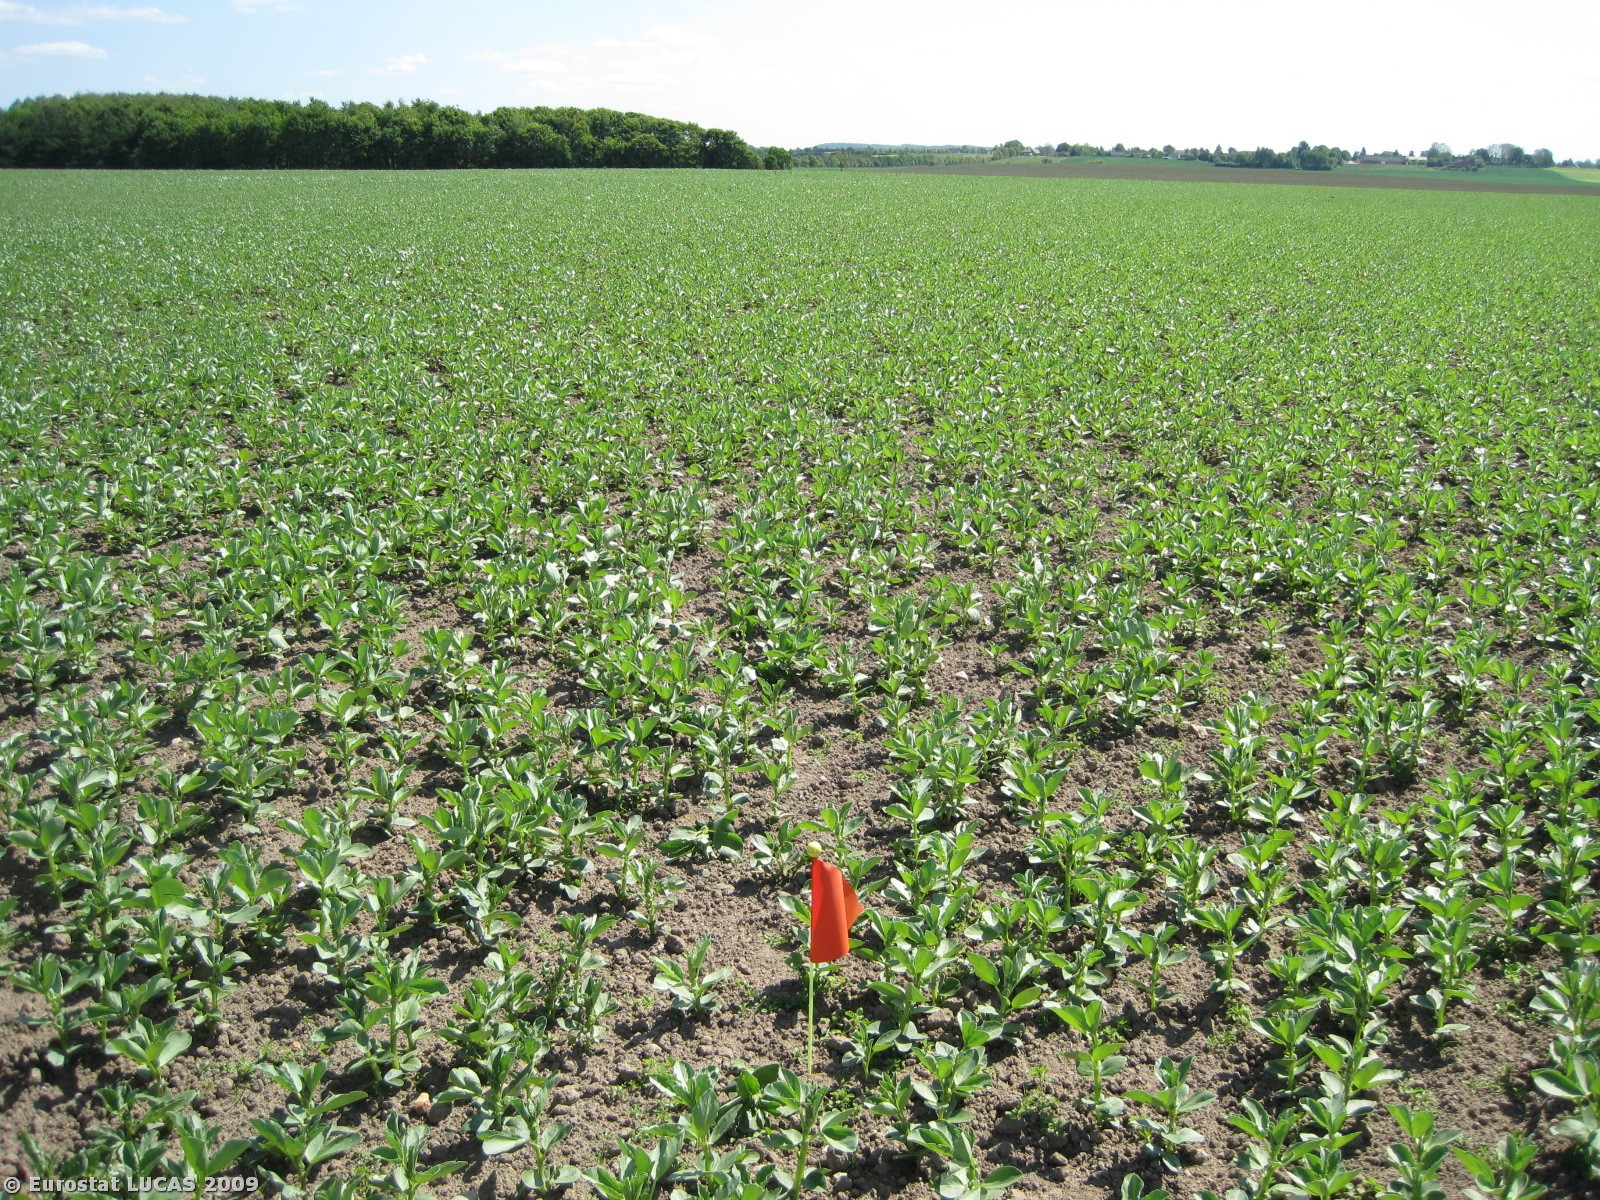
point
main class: Cropland
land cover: Dry pulses
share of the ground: 25 - 50 %
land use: Agriculture (excluding fallow land and kitchen gardens)
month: May
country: DK
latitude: 56.5110
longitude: 10.2759
